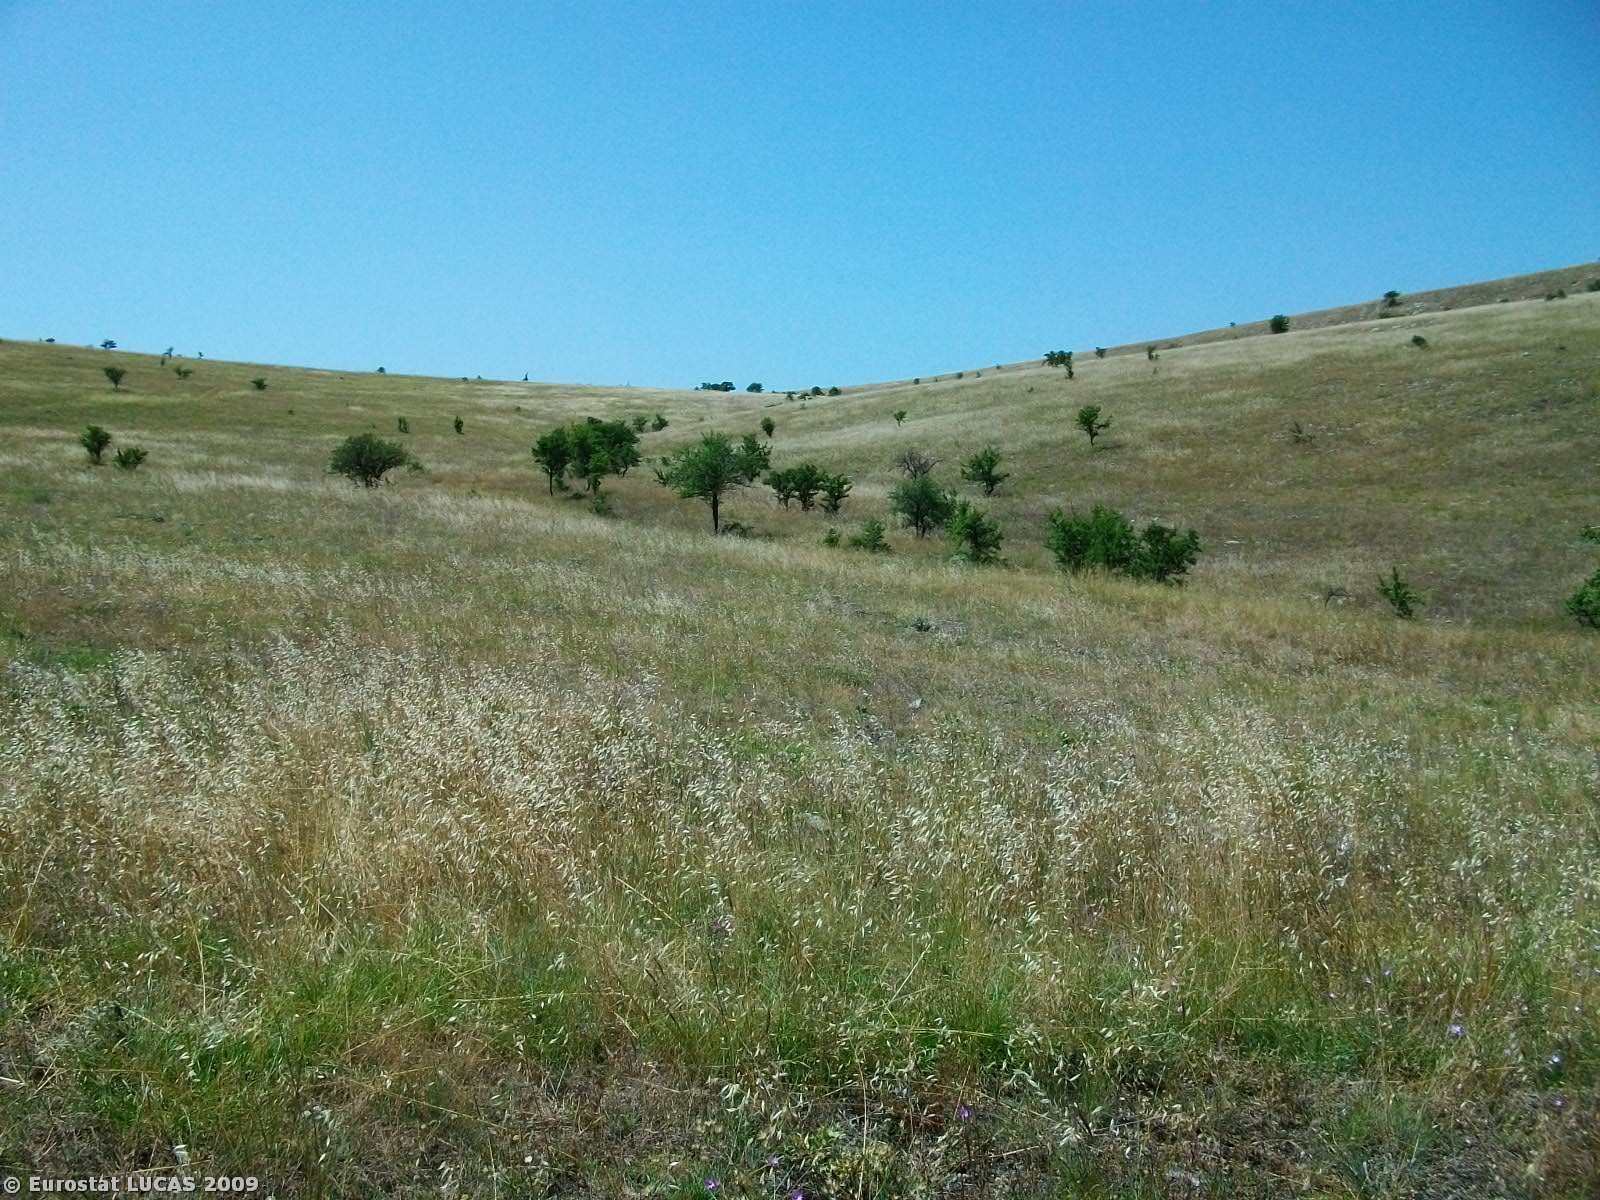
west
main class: Grassland
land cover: Grassland without tree/shrub cover
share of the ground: > 75 %
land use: Unused
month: July
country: GR
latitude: 40.3436
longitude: 21.7527
